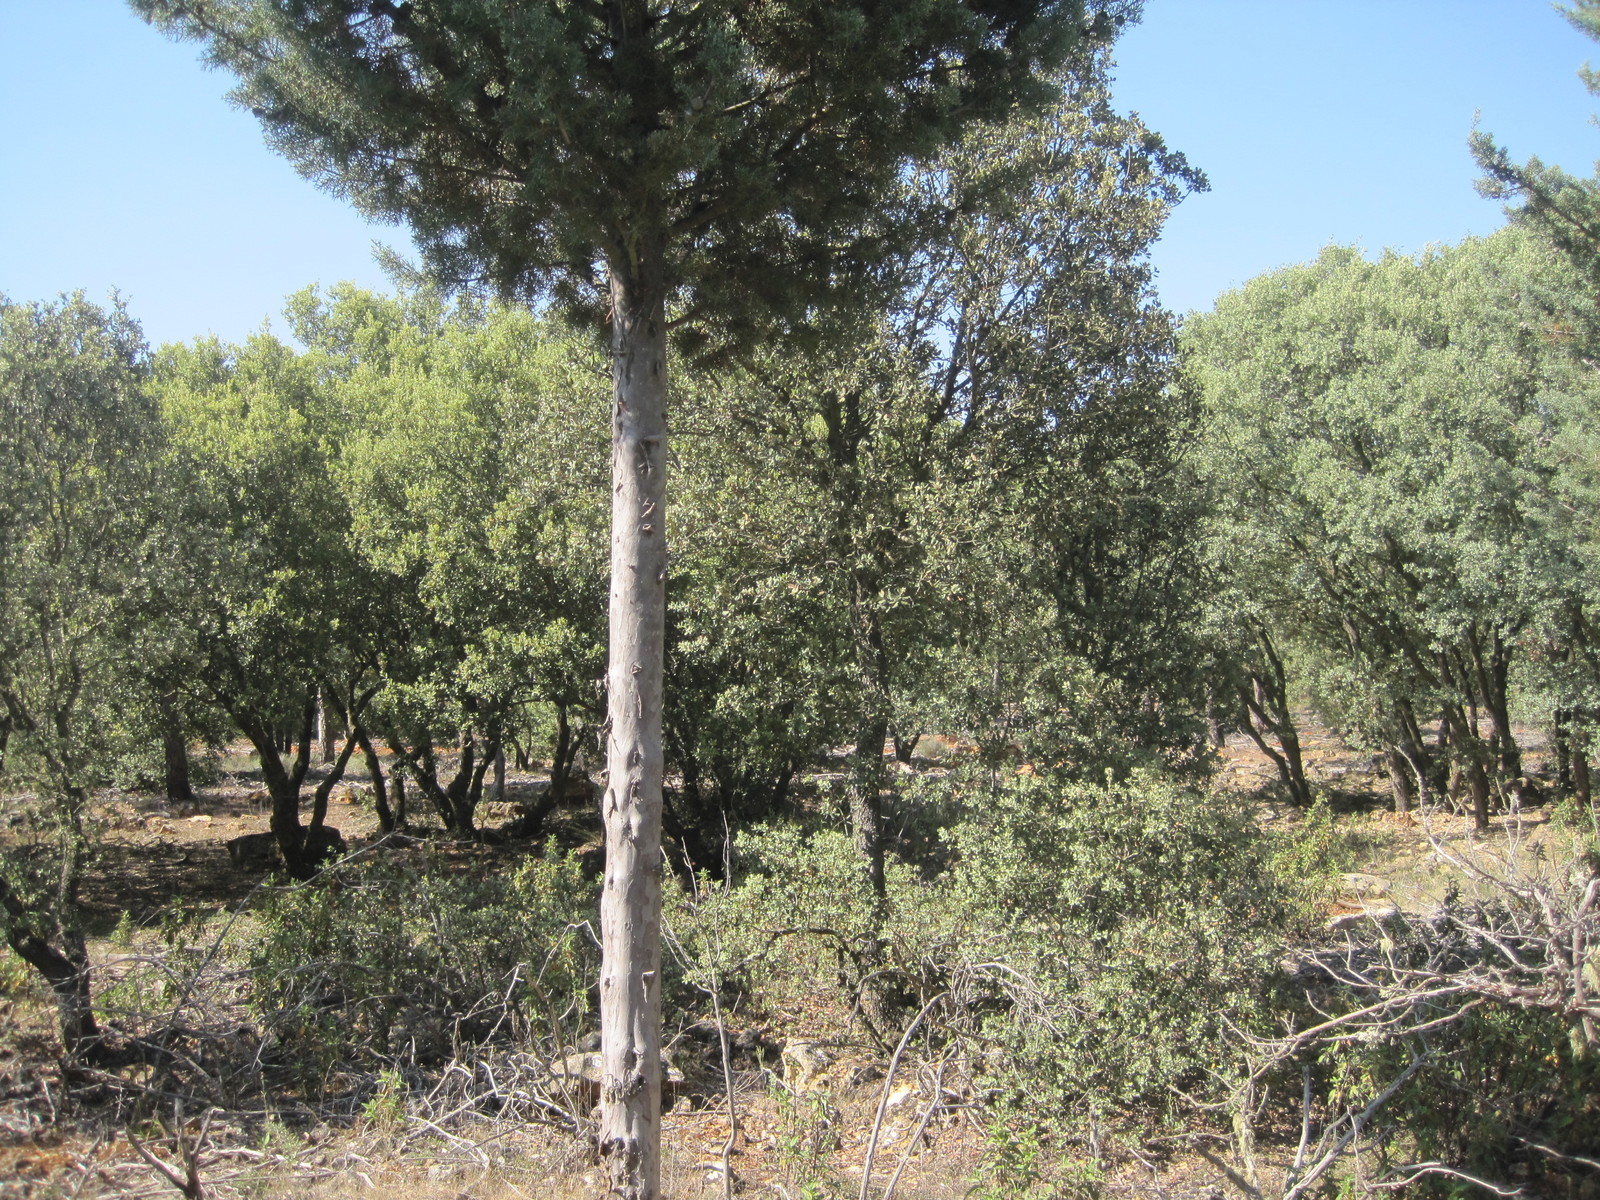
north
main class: Woodland
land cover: Pine dominated mixed woodland
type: coniferous forest of the mediterranean region
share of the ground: > 75 %
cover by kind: coniferous forest trees 50 %, broadleaved forest trees 30 %, herbaceous plants 20 %
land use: Forestry
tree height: > 5 m
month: July
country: ES
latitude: 41.8843
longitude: -4.7138
